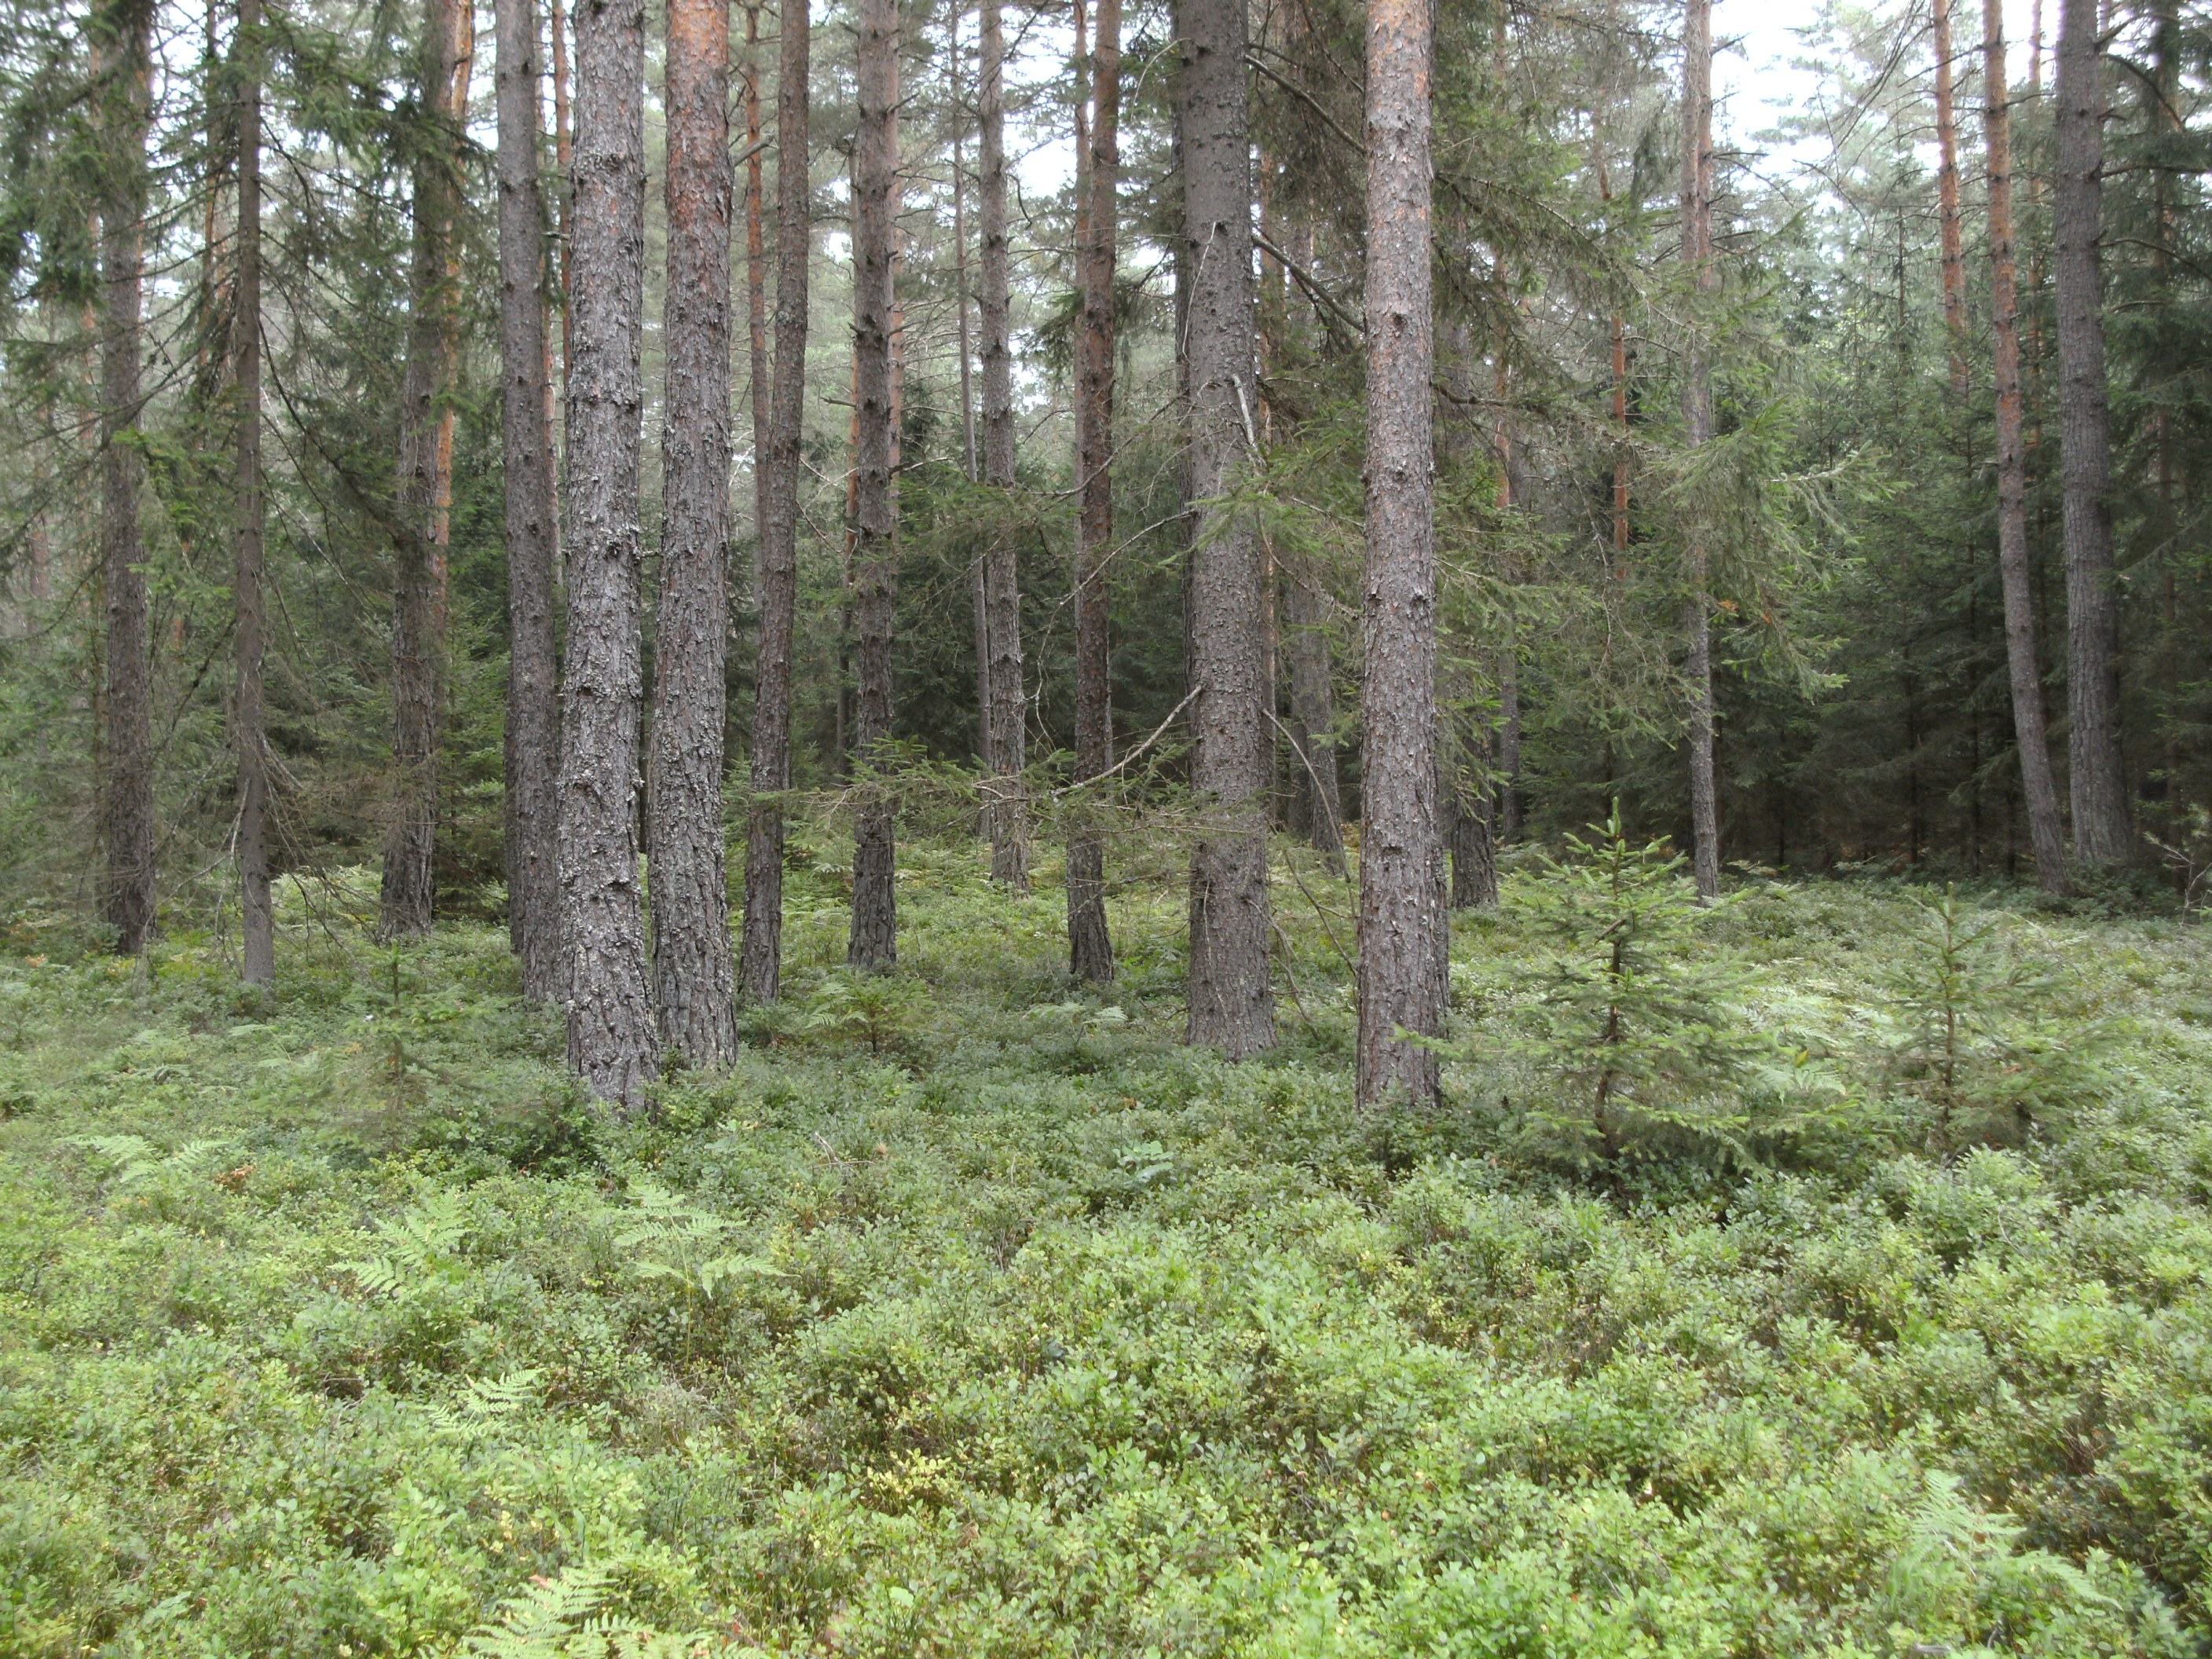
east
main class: Woodland
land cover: Pine dominated coniferous woodland
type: hemiboreal forest and nemoral coniferous forest and mixed broadleaved-coniferous forest
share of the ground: 25 - 50 %
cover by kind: shrubs 50 %, coniferous forest trees 40 %, herbaceous plants 5 %, lichens and mosses 5 %
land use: Forestry
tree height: > 5 m
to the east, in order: Pine dominated coniferous woodland; Other coniferous woodland; Tracks; Spruce dominated coniferous woodland; Other coniferous woodland; Tracks; Spruce dominated coniferous woodland; Other coniferous woodland; Pine dominated coniferous woodland; Tracks; Spruce dominated coniferous woodland; Spruce dominated mixed woodland
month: July
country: AT
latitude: 46.5914
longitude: 14.6834
